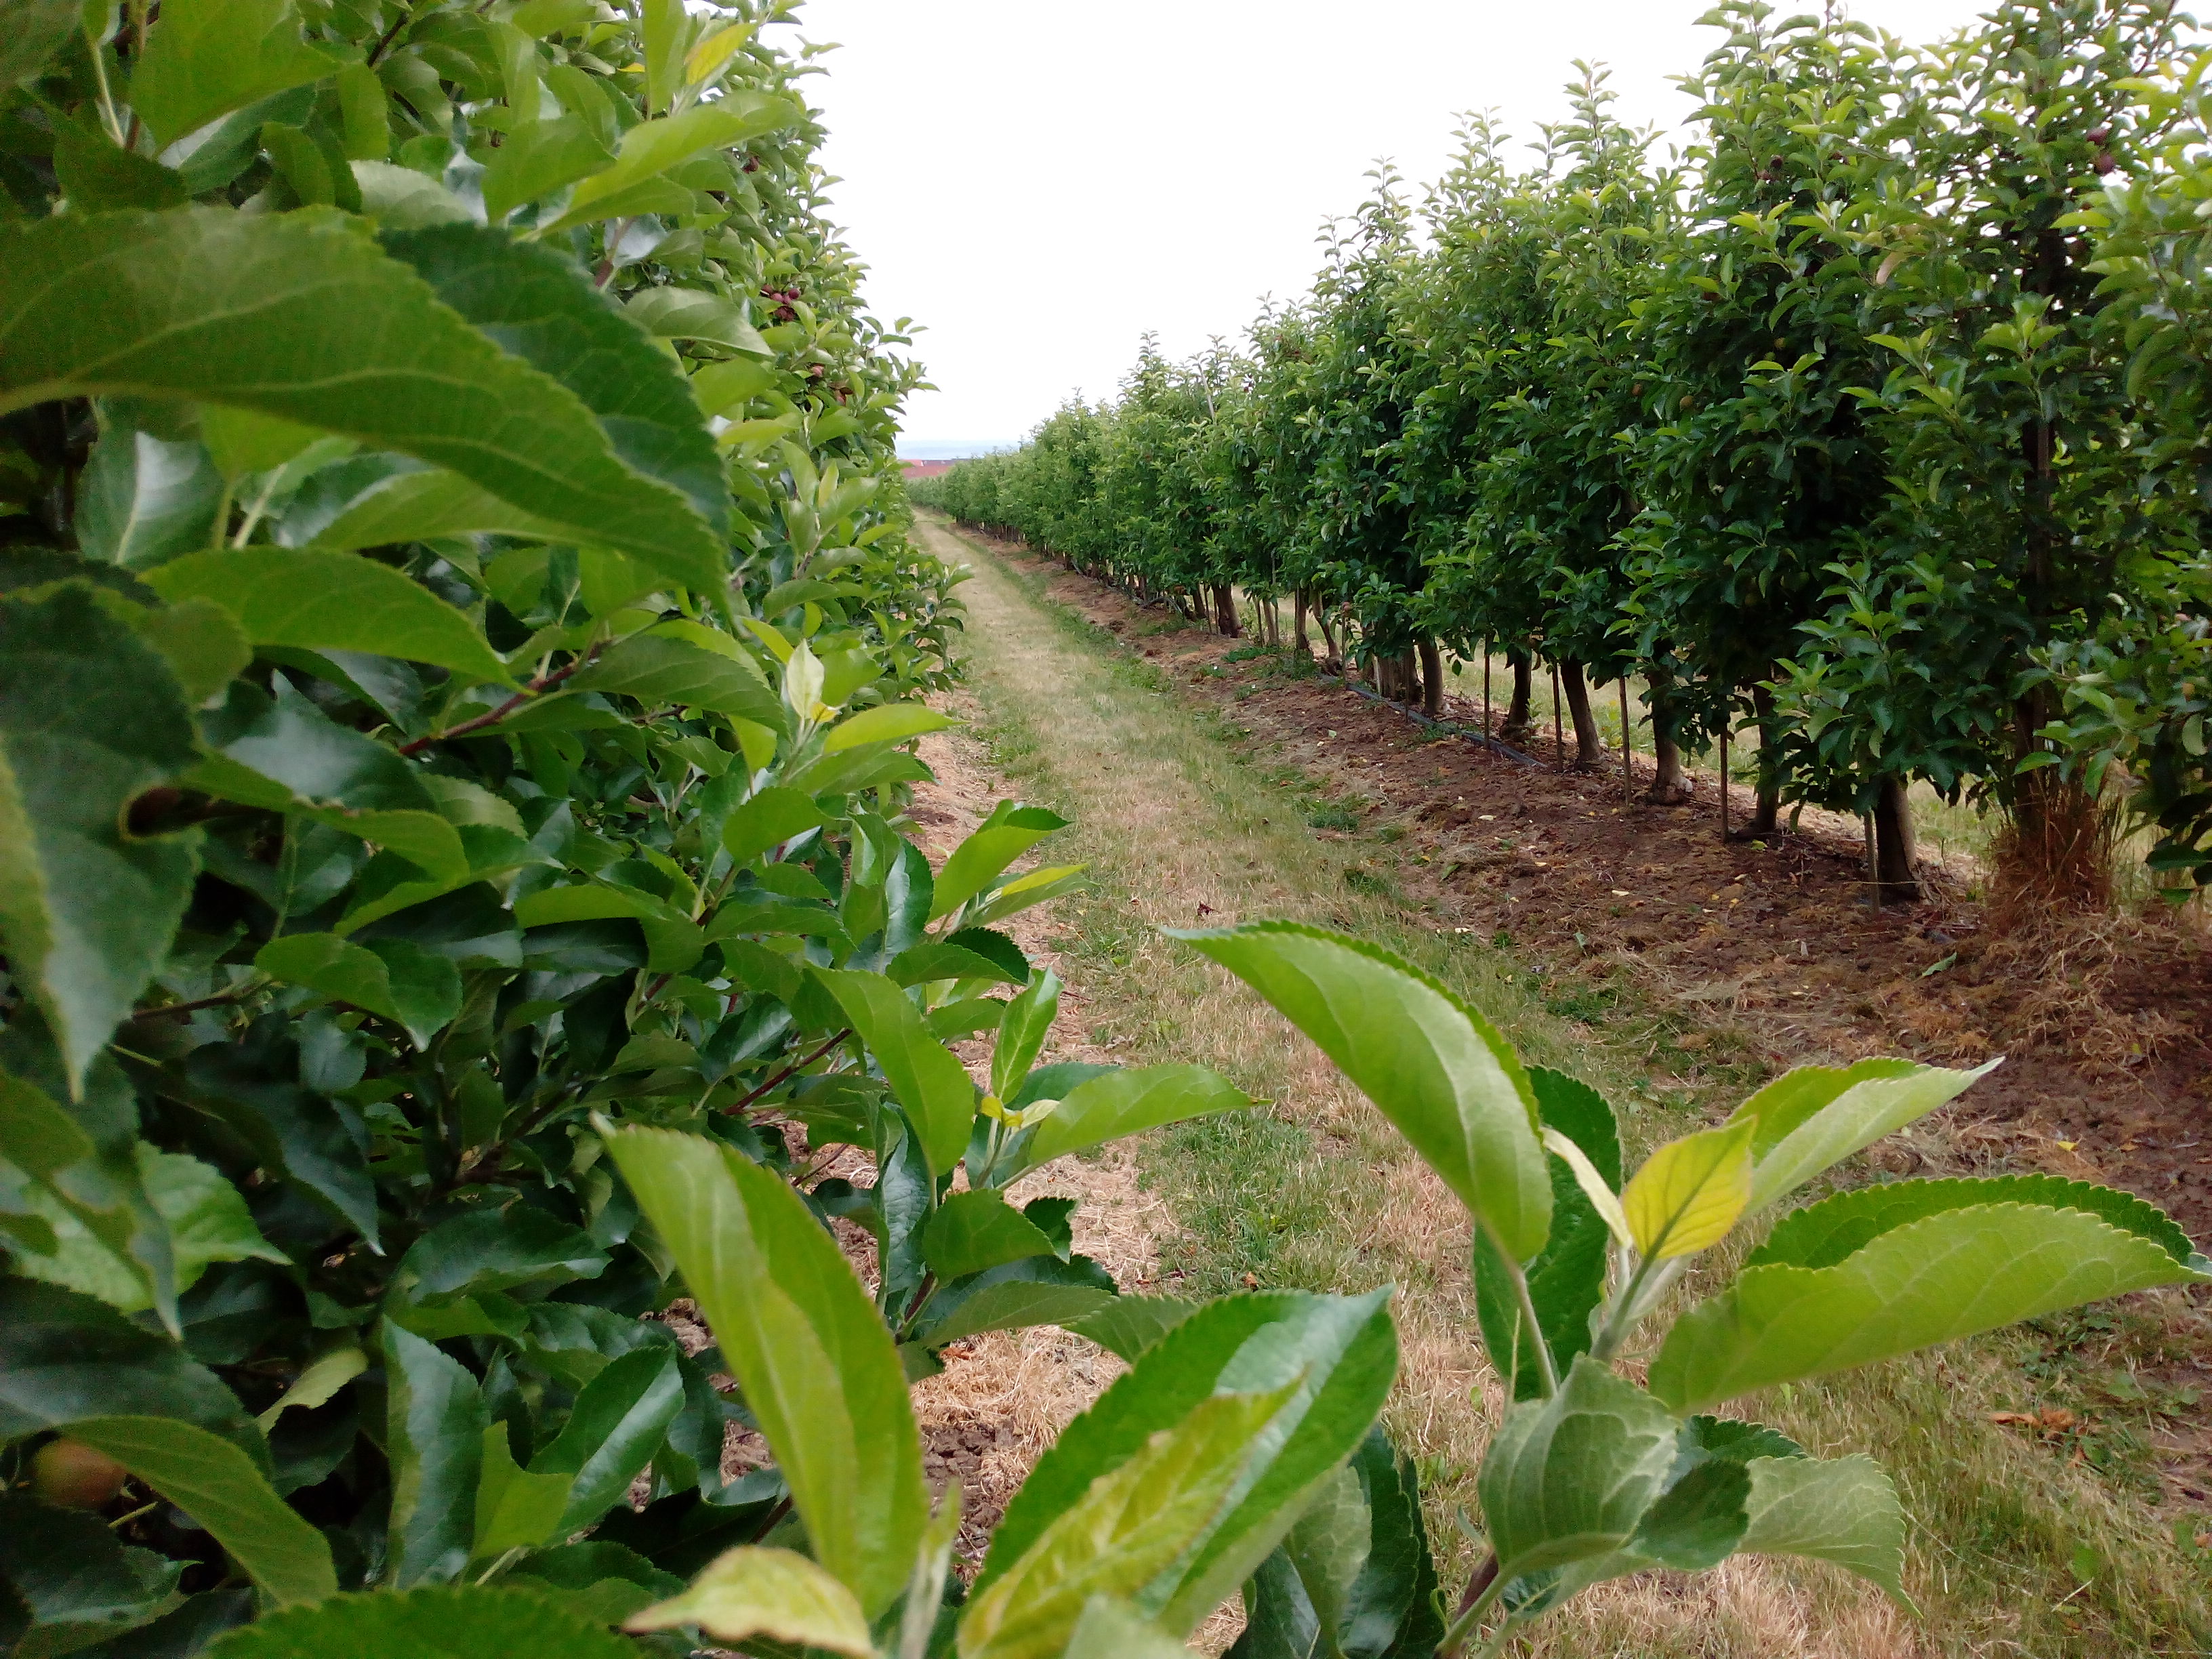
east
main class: Cropland
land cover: Apple fruit
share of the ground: 25 - 50 %
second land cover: Grassland without tree/shrub cover
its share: 50 - 75 %
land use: Agriculture (excluding fallow land and kitchen gardens)
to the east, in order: Apple fruit; Grassland without tree/shrub cover; Electric lines; Grassland without tree/shrub cover; Tracks; Grassland without tree/shrub cover; Apple fruit
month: June
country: DE
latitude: 51.2580
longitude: 11.0744
